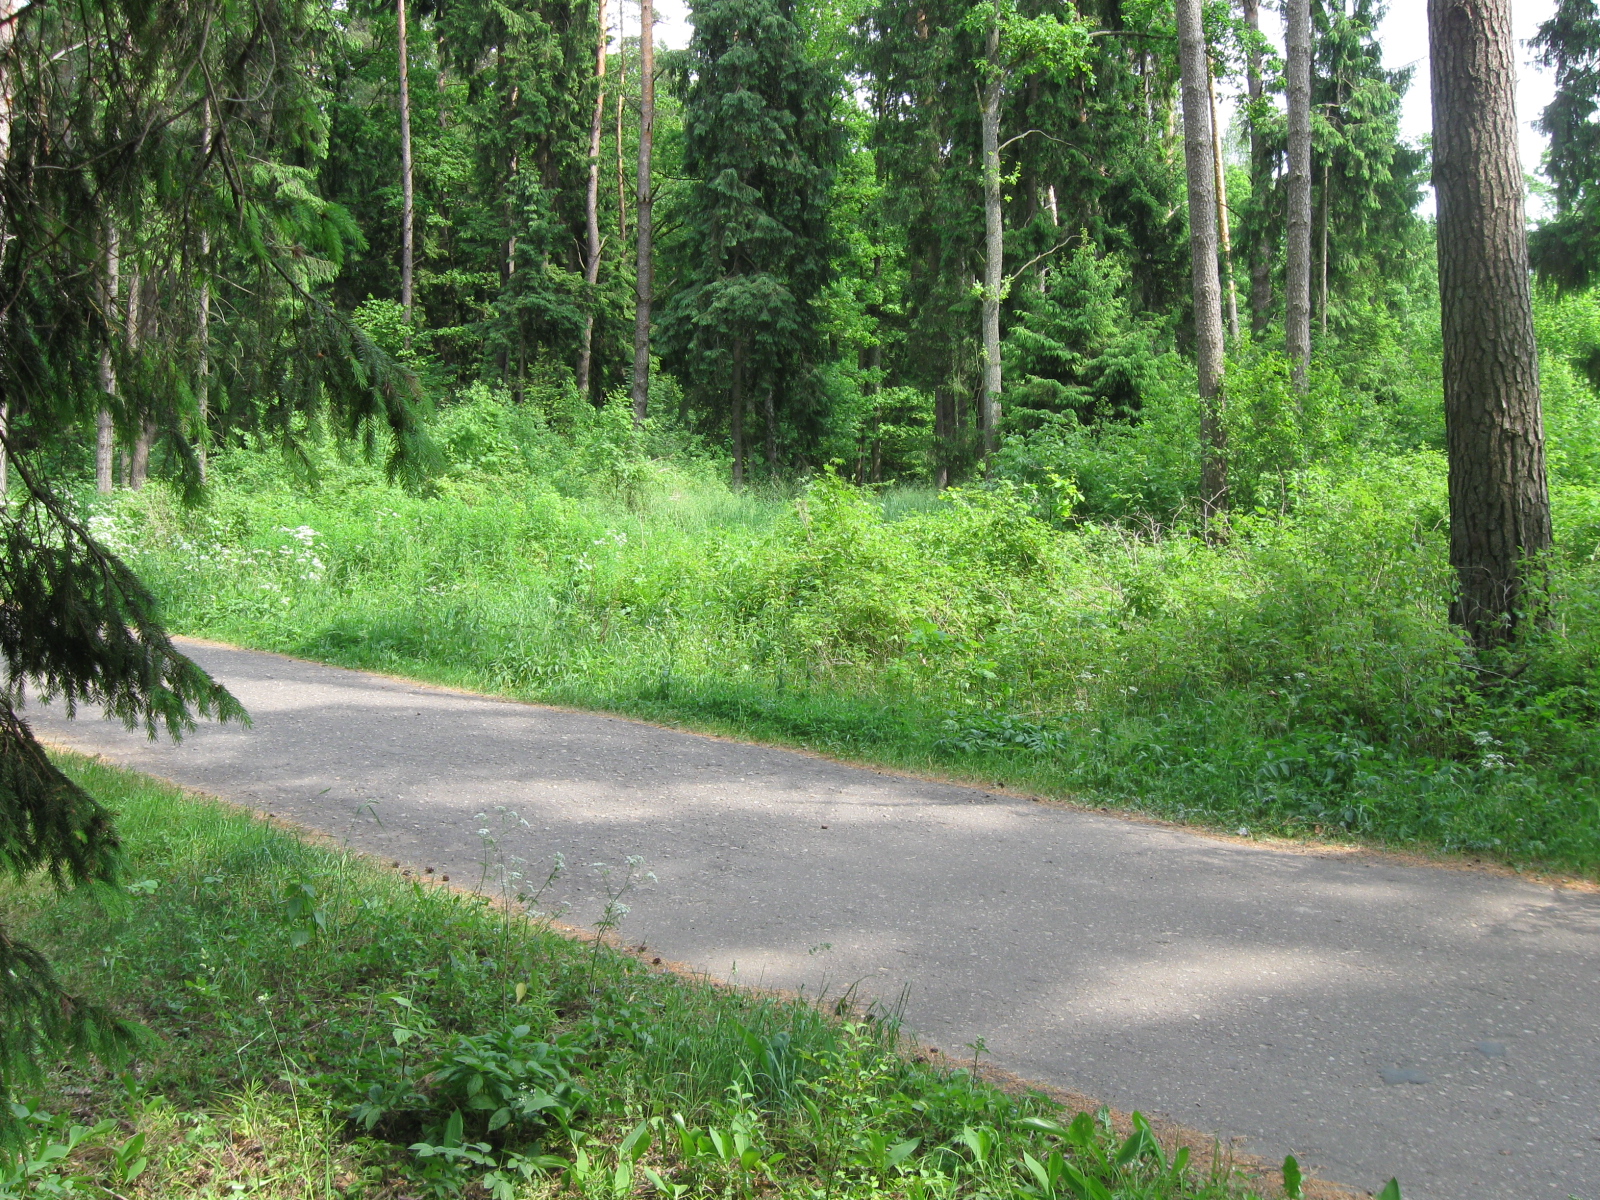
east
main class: Woodland
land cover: Spruce dominated coniferous woodland
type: hemiboreal forest and nemoral coniferous forest and mixed broadleaved-coniferous forest
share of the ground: > 75 %
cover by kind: coniferous forest trees 85 %, herbaceous plants 10 %, unconsolidated bare surface 5 %
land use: Forestry
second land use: Sport
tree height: > 5 m
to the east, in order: Paved roads, cycling and walking lanes; Other coniferous woodland; Tracks; Pine dominated mixed woodland; Electric lines; Pine dominated mixed woodland; Other mixed woodland
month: June
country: LT
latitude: 54.9433
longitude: 23.9684
